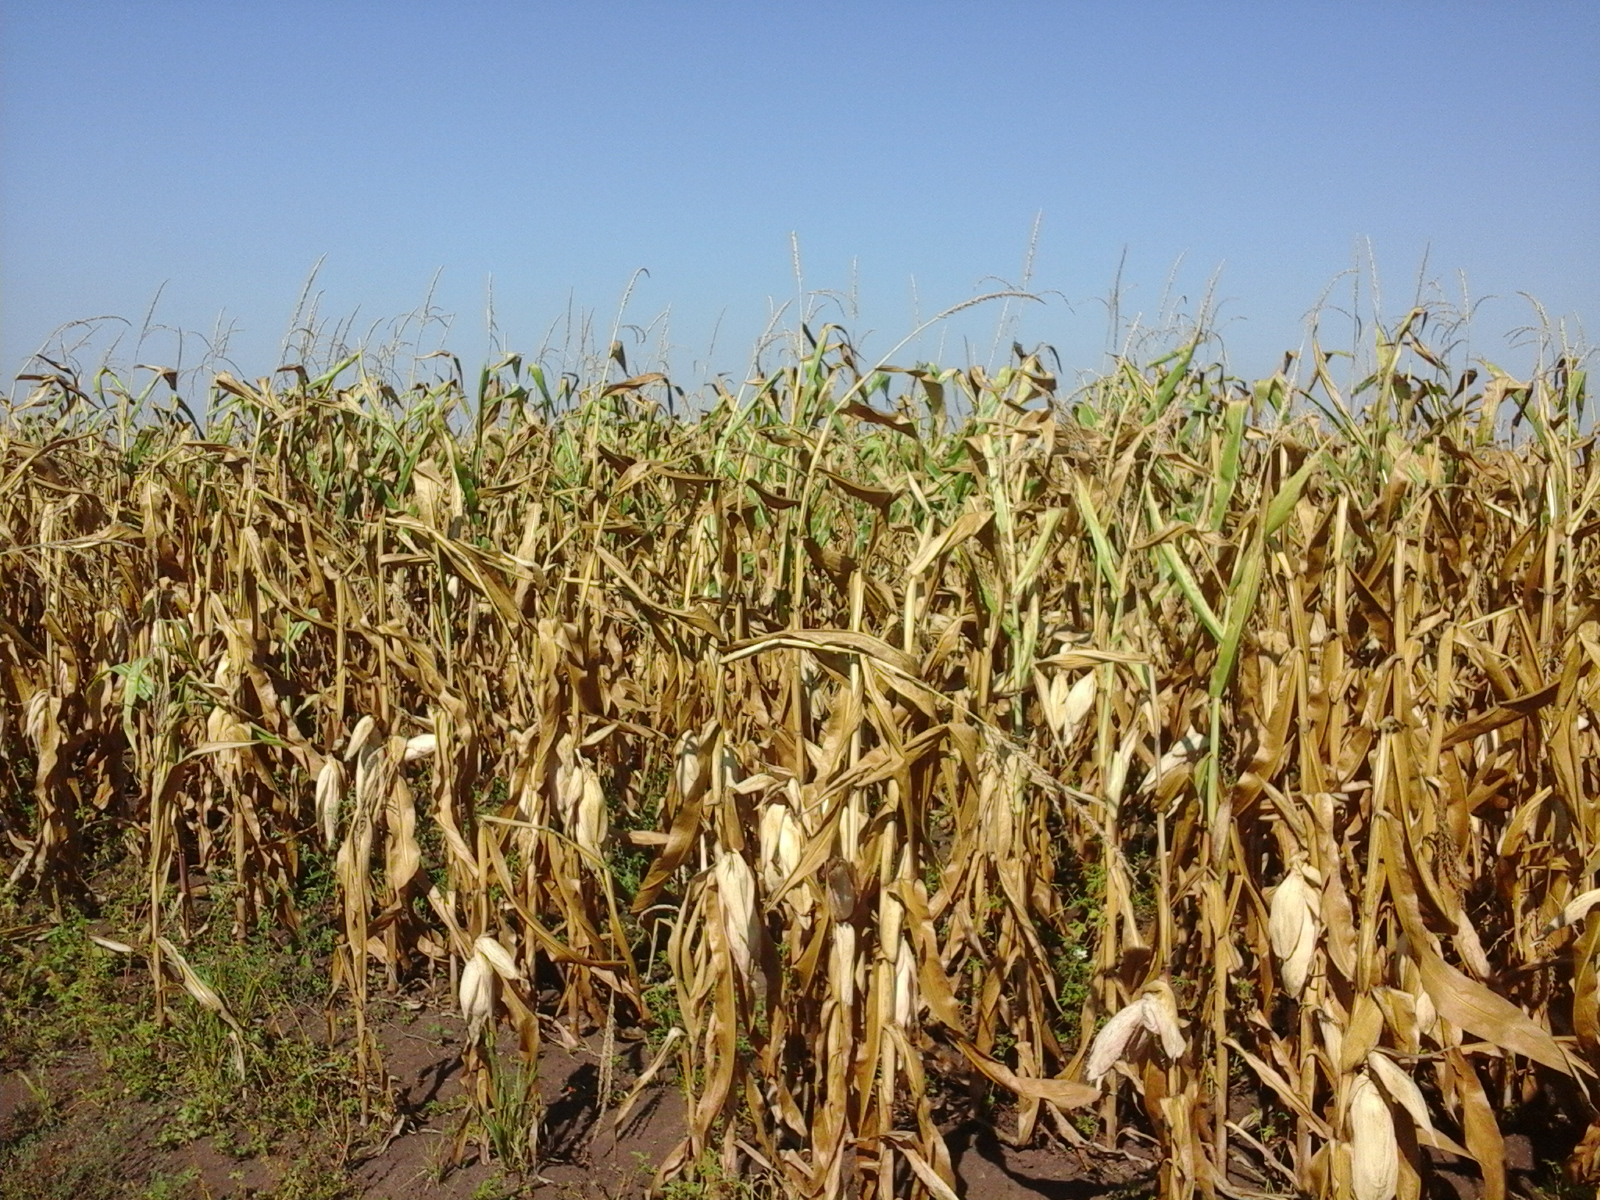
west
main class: Cropland
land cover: Maize
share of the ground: > 75 %
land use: Agriculture (excluding fallow land and kitchen gardens)
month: August
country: RO
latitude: 45.8862
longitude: 21.0468
